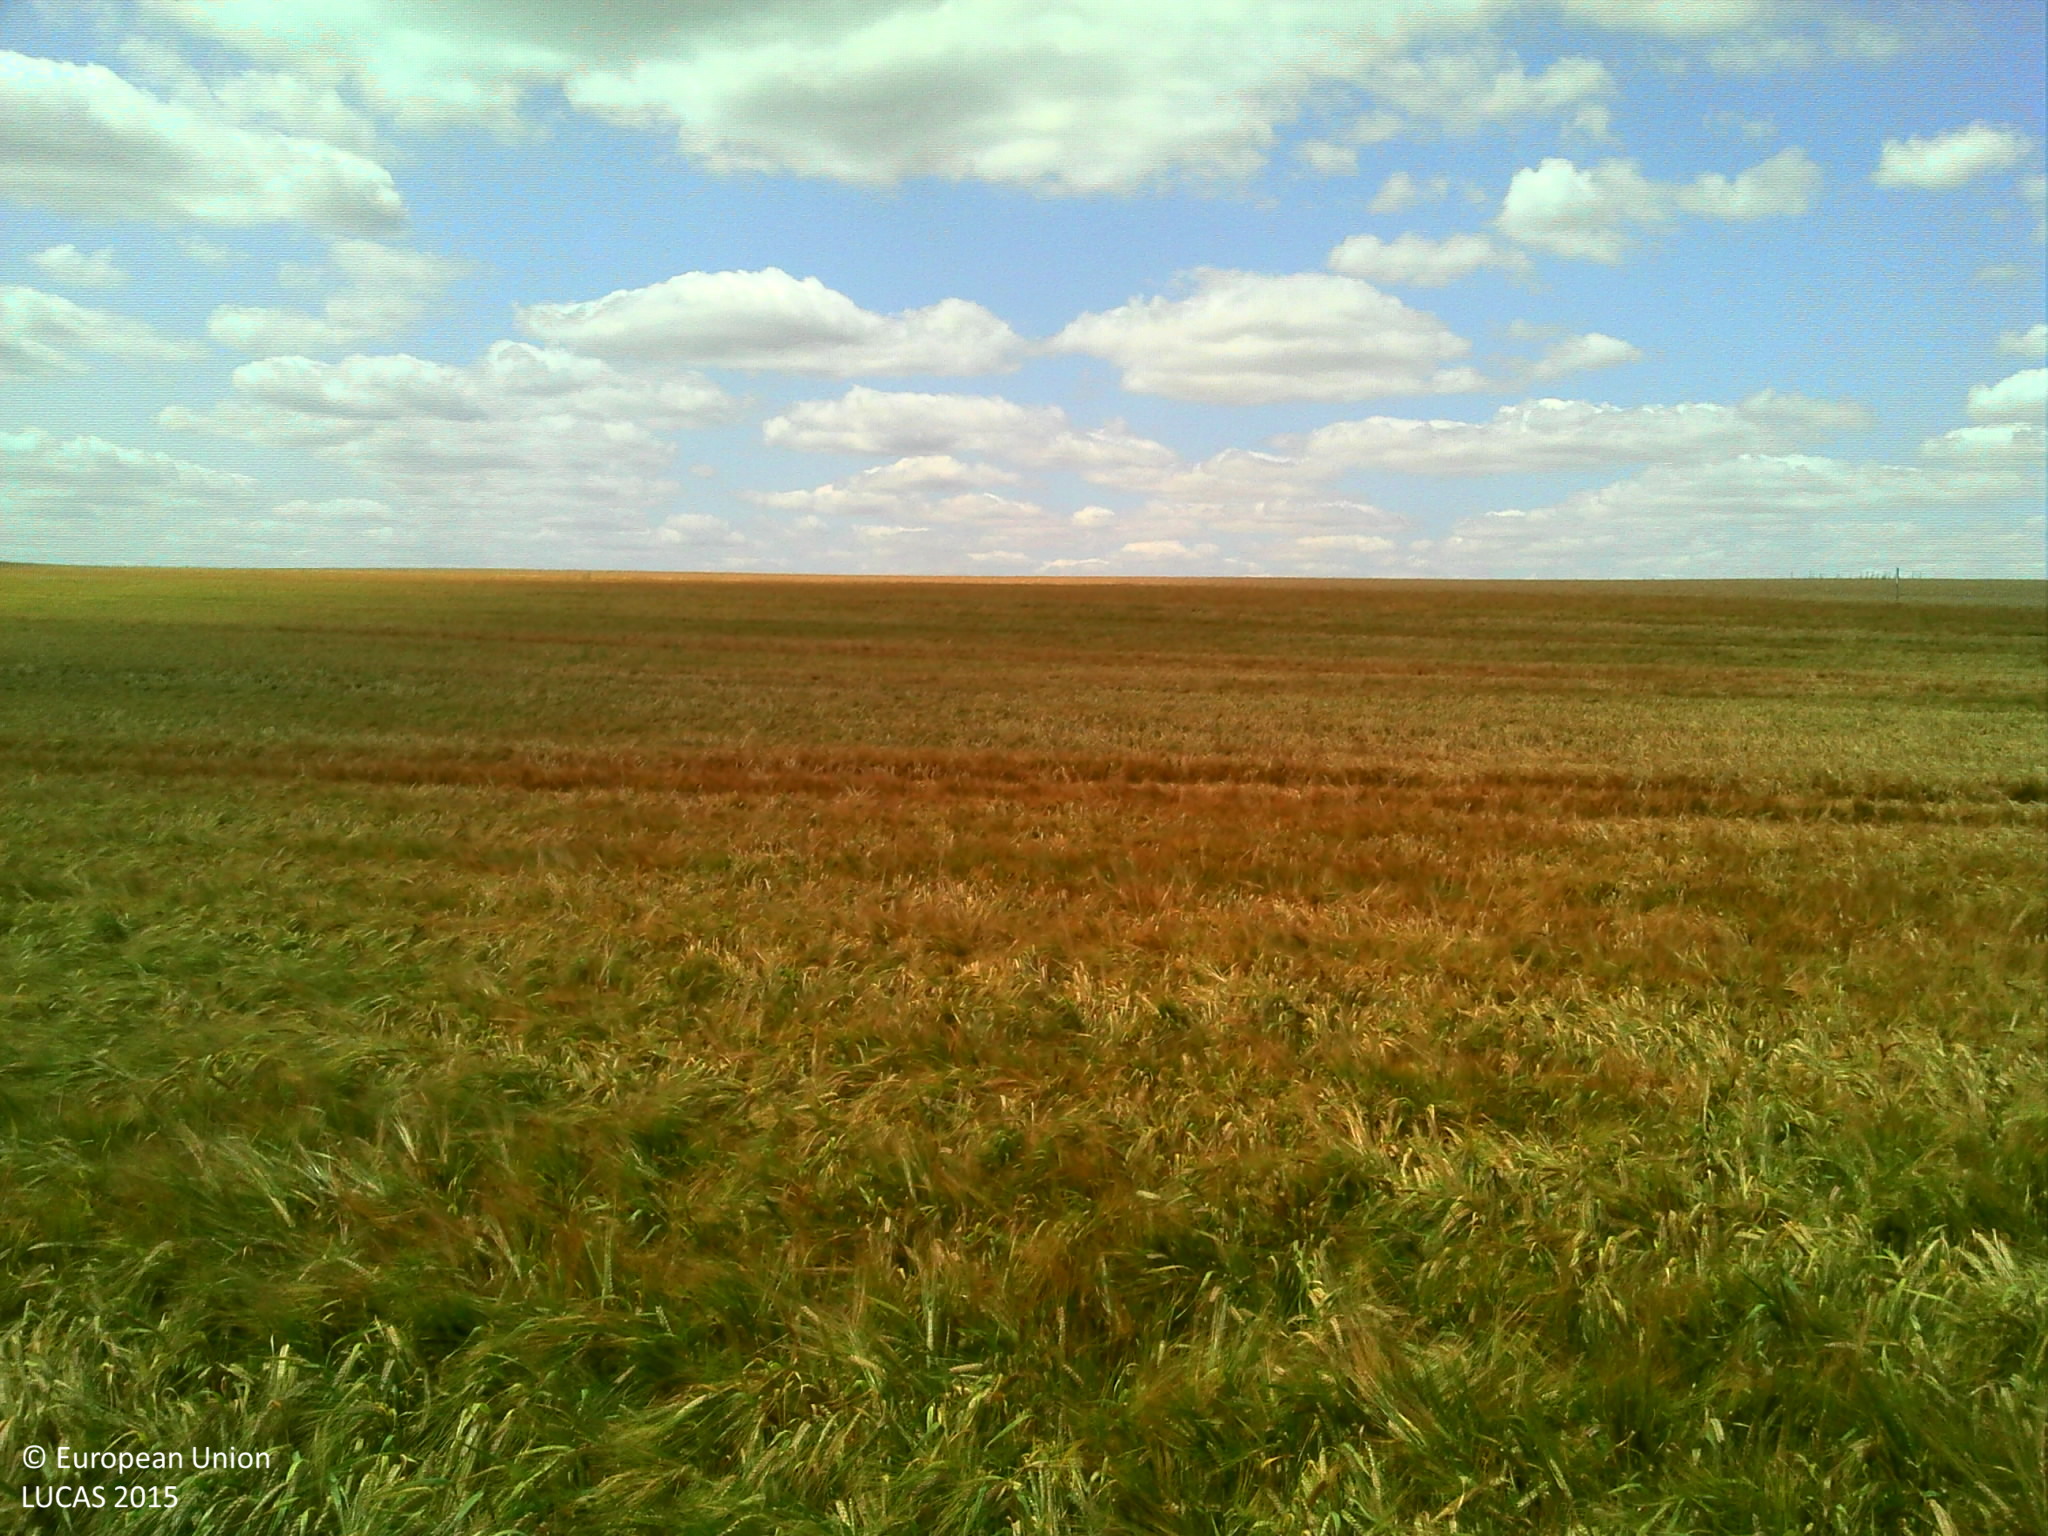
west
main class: Cropland
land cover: Barley
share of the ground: > 75 %
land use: Agriculture (excluding fallow land and kitchen gardens)
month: July
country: FR
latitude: 49.2843
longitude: 1.9426
